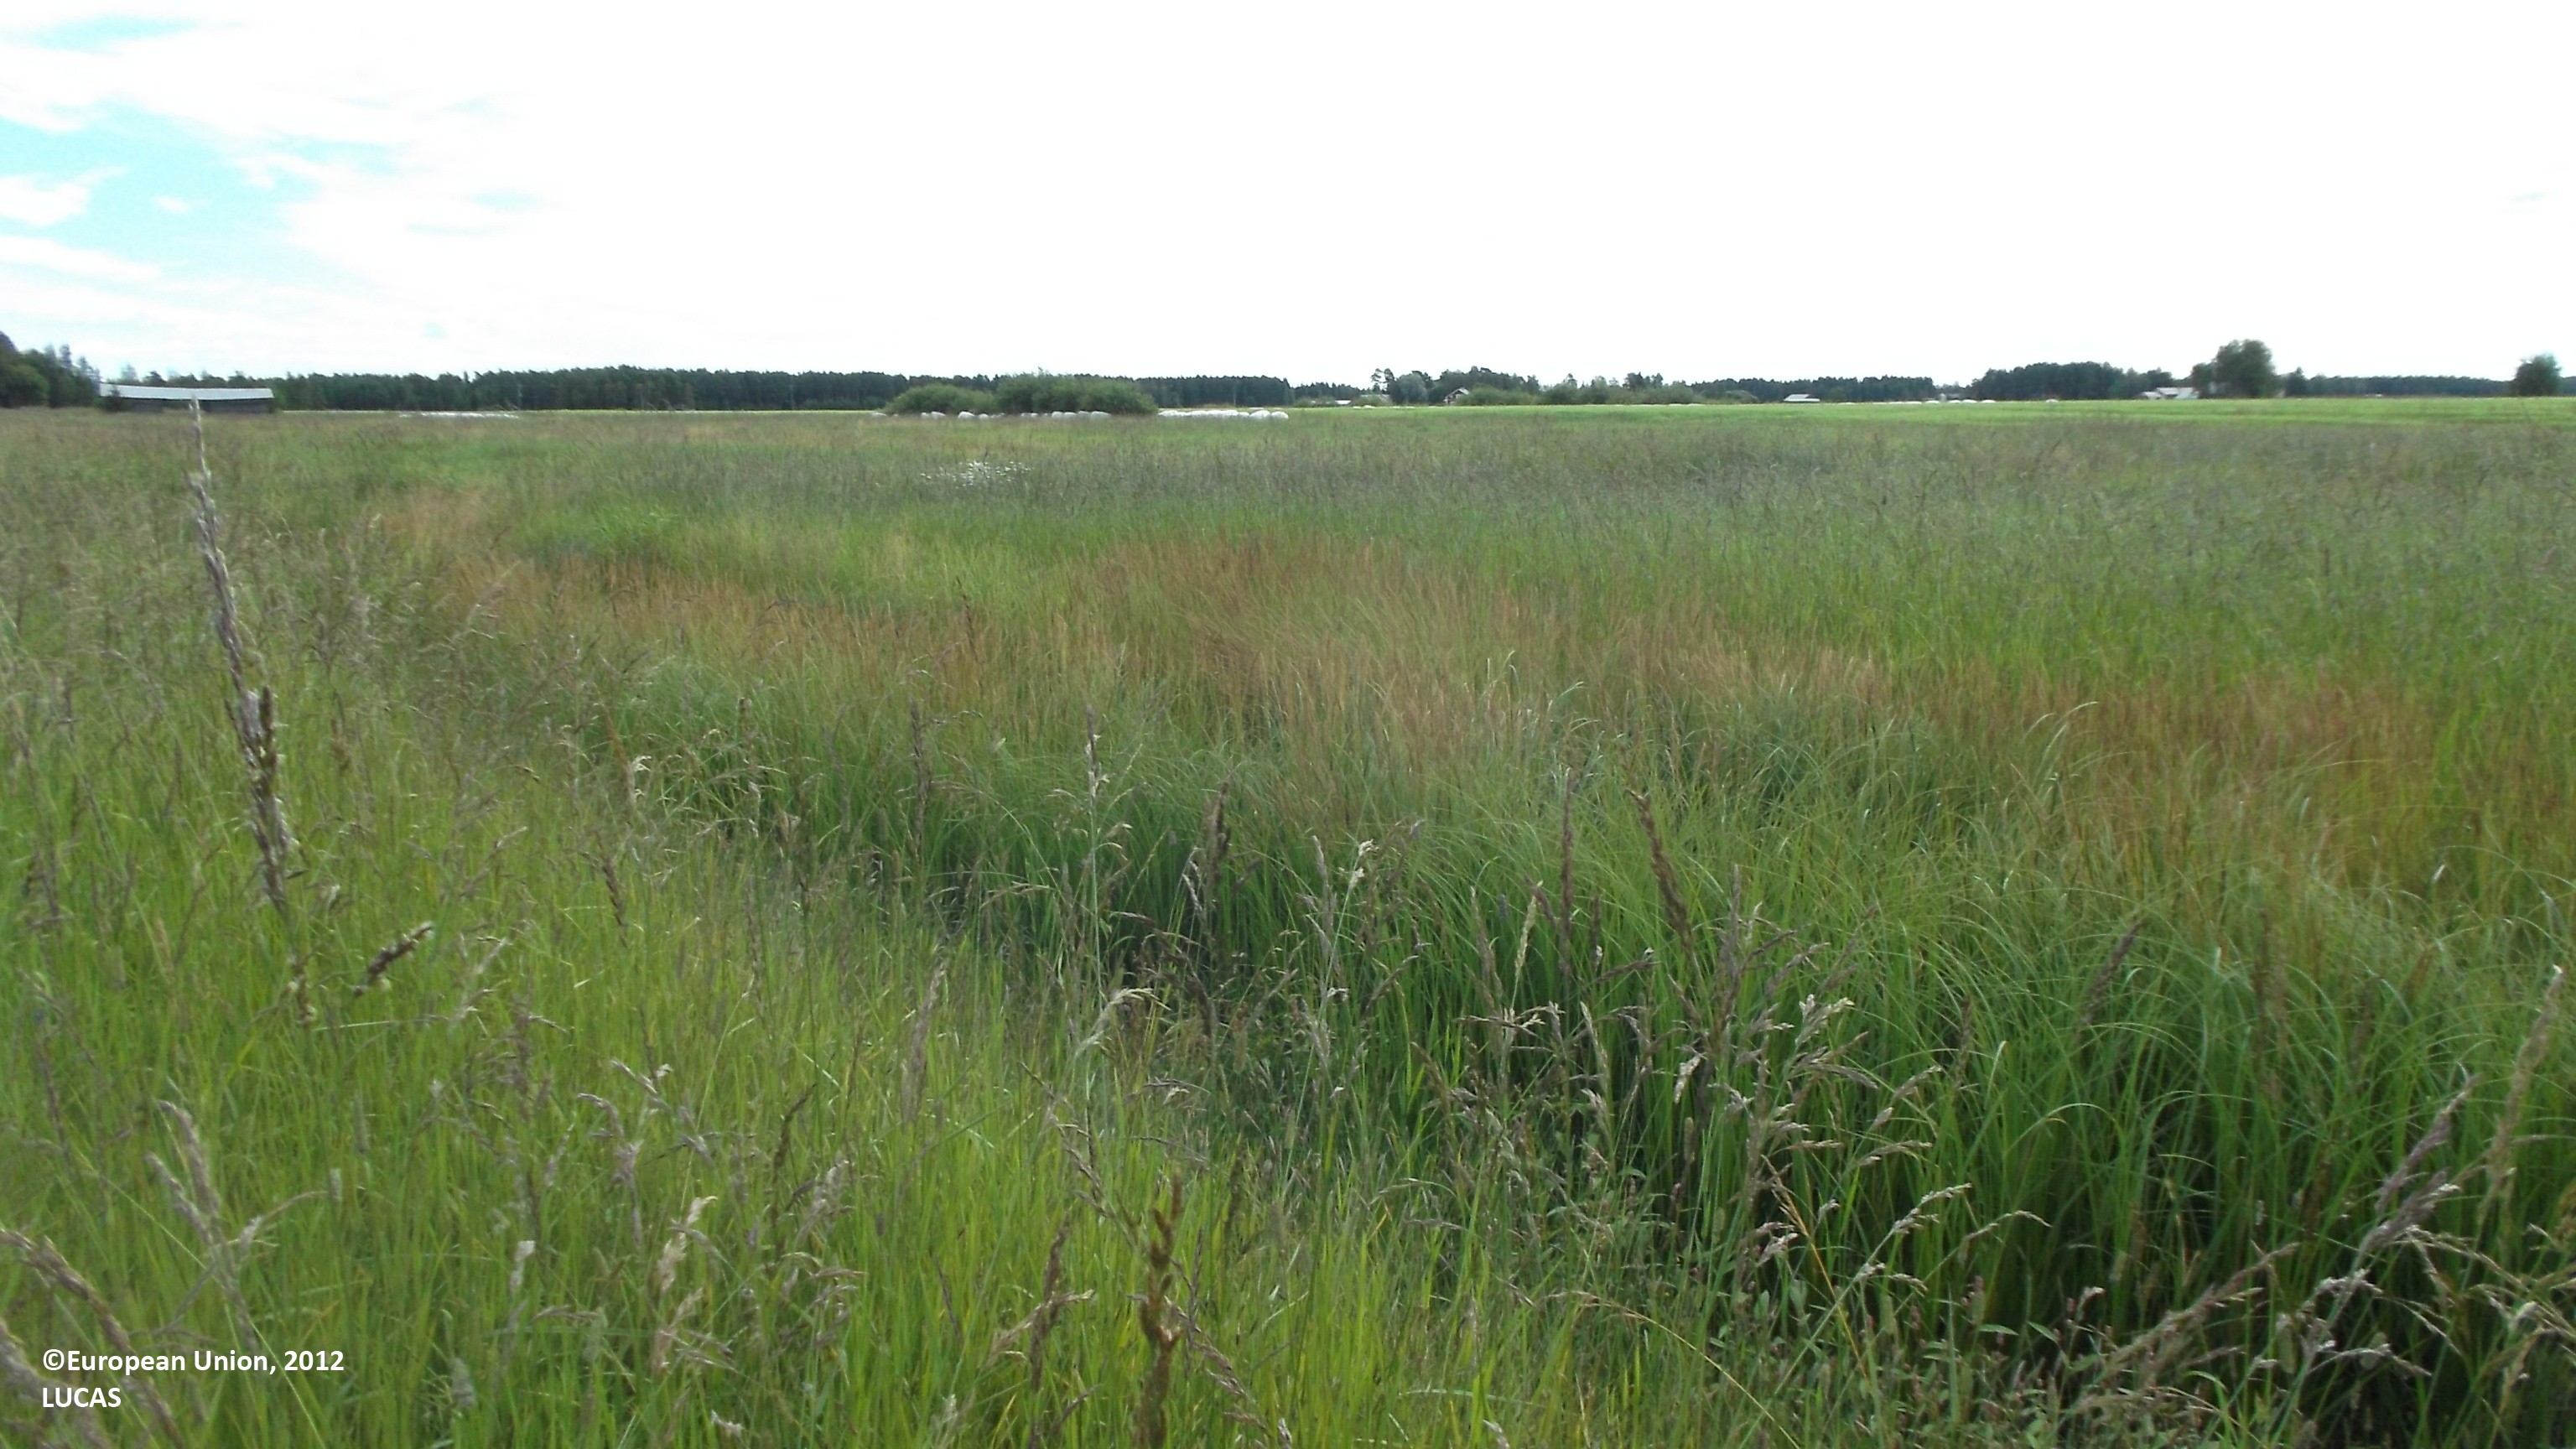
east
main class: Grassland
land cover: Spontaneously vegetated surfaces
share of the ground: > 75 %
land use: Fallow land
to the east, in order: Spontaneously vegetated surfaces; Ditches and canals; Grassland without tree/shrub cover; Ditches and canals; Grassland without tree/shrub cover; Ditches and canals; Grassland without tree/shrub cover; Ditches and canals; Barley; Ditches and canals; Barley; Ditches and canals; Barley; Ditches and canals; Barley; Ditches and canals; Grassland without tree/shrub cover; Ditches and canals; Grassland without tree/shrub cover
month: July
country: FI
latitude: 64.0026
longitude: 23.4910
